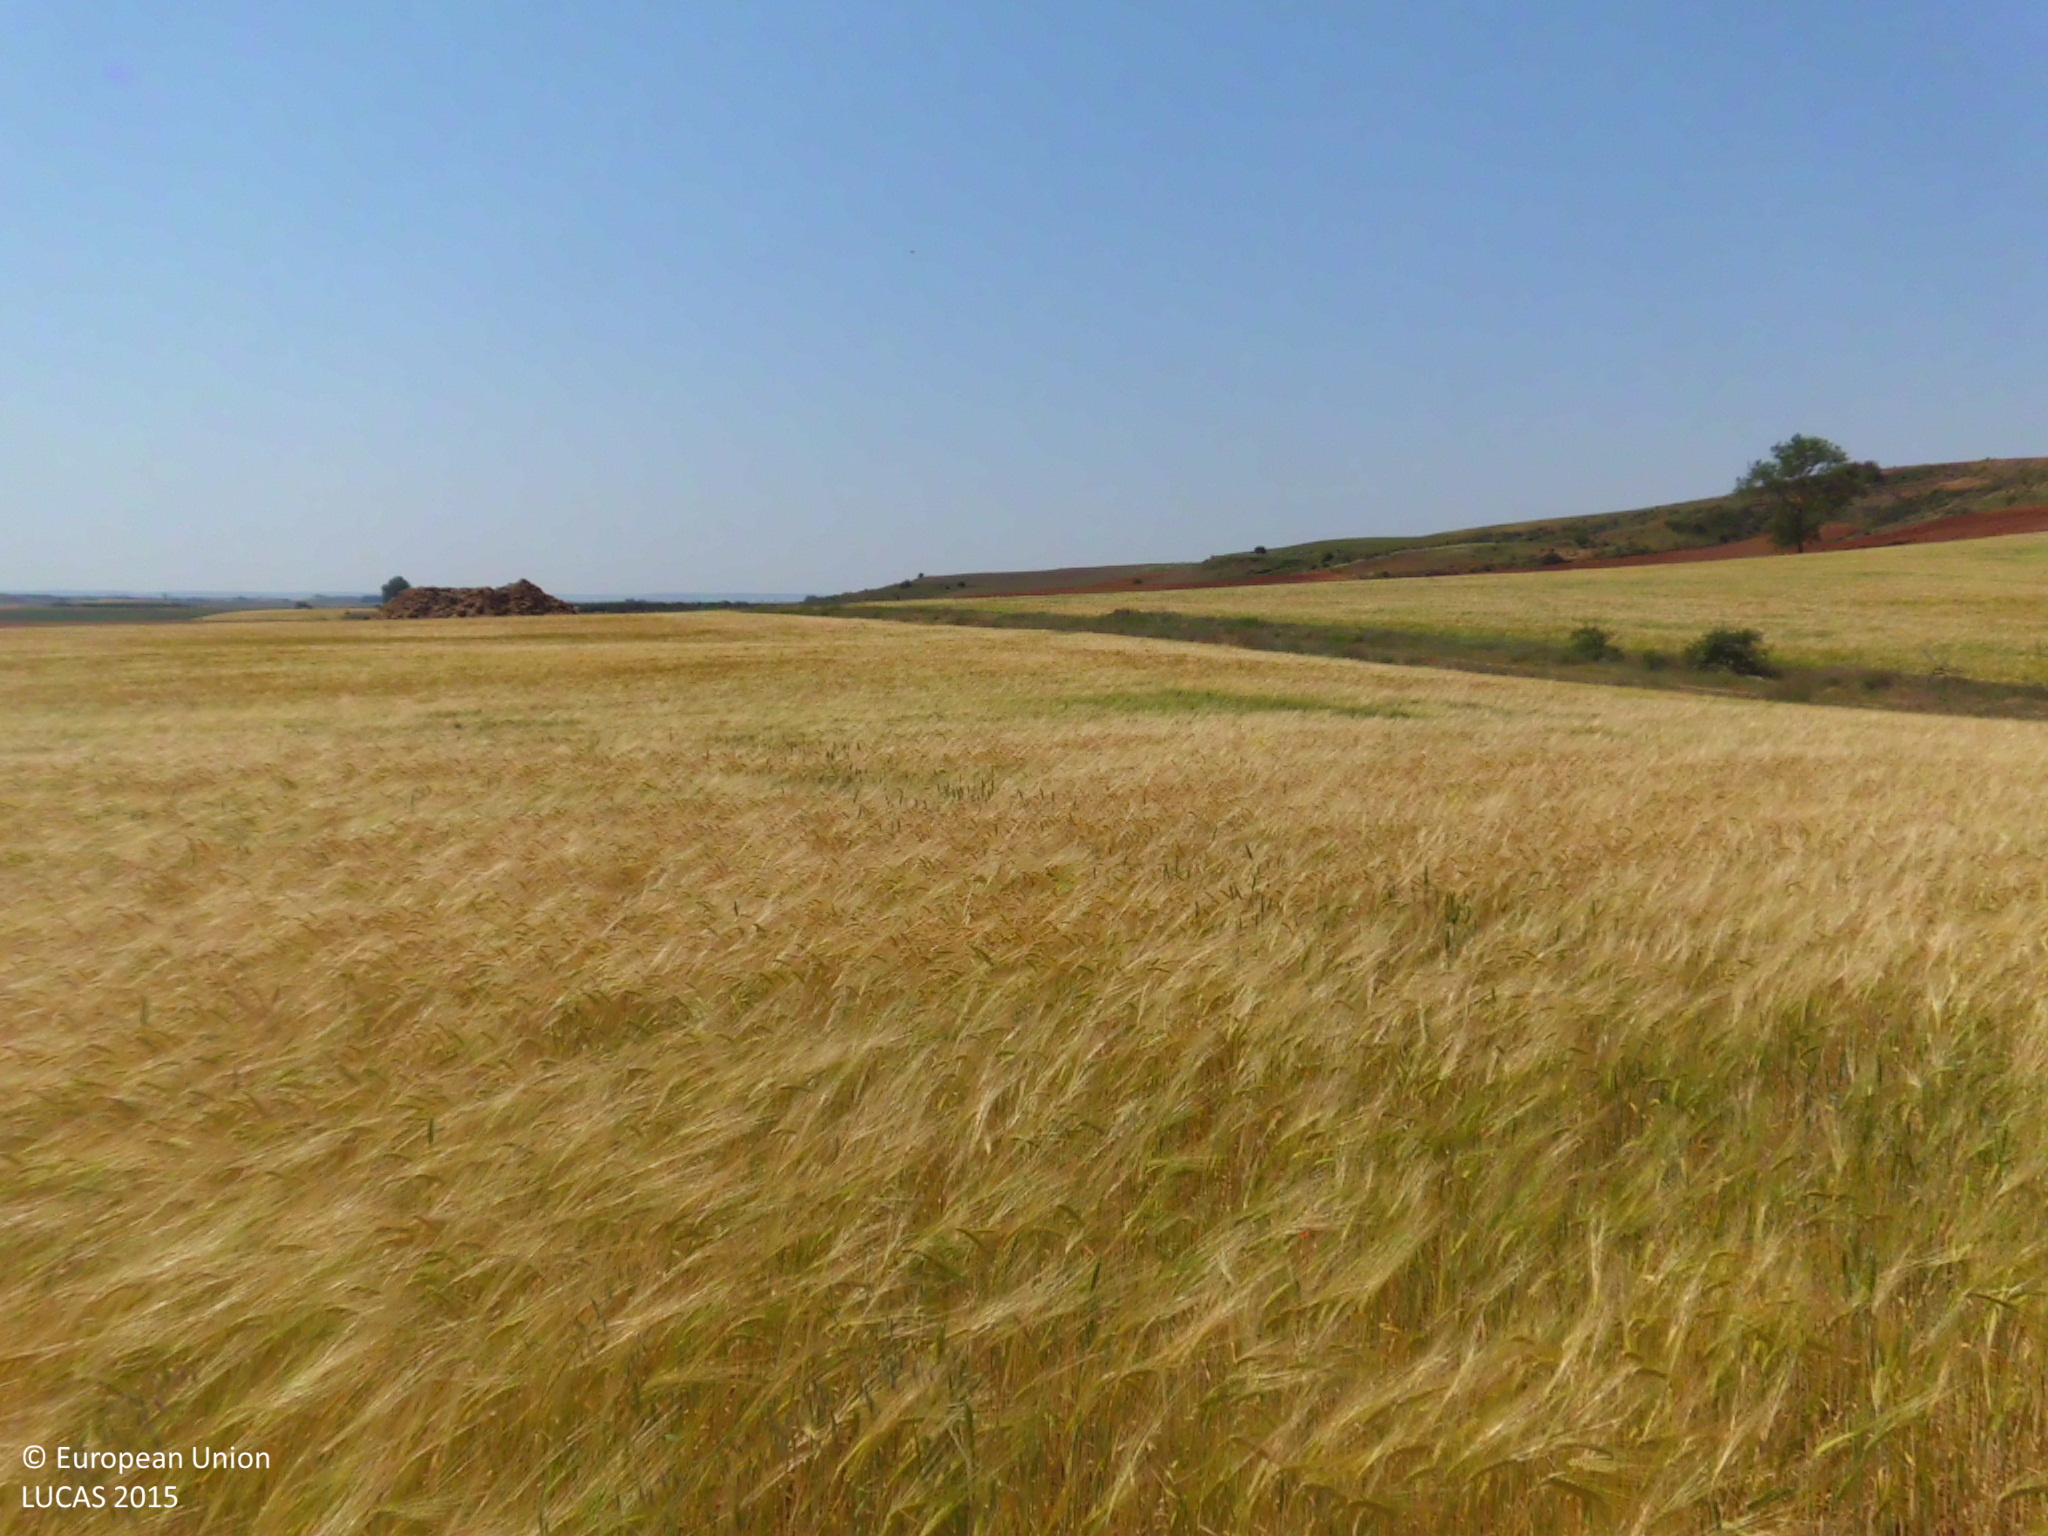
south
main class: Cropland
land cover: Barley
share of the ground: > 75 %
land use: Agriculture (excluding fallow land and kitchen gardens)
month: June
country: ES
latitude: 42.5402
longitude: -4.2323
